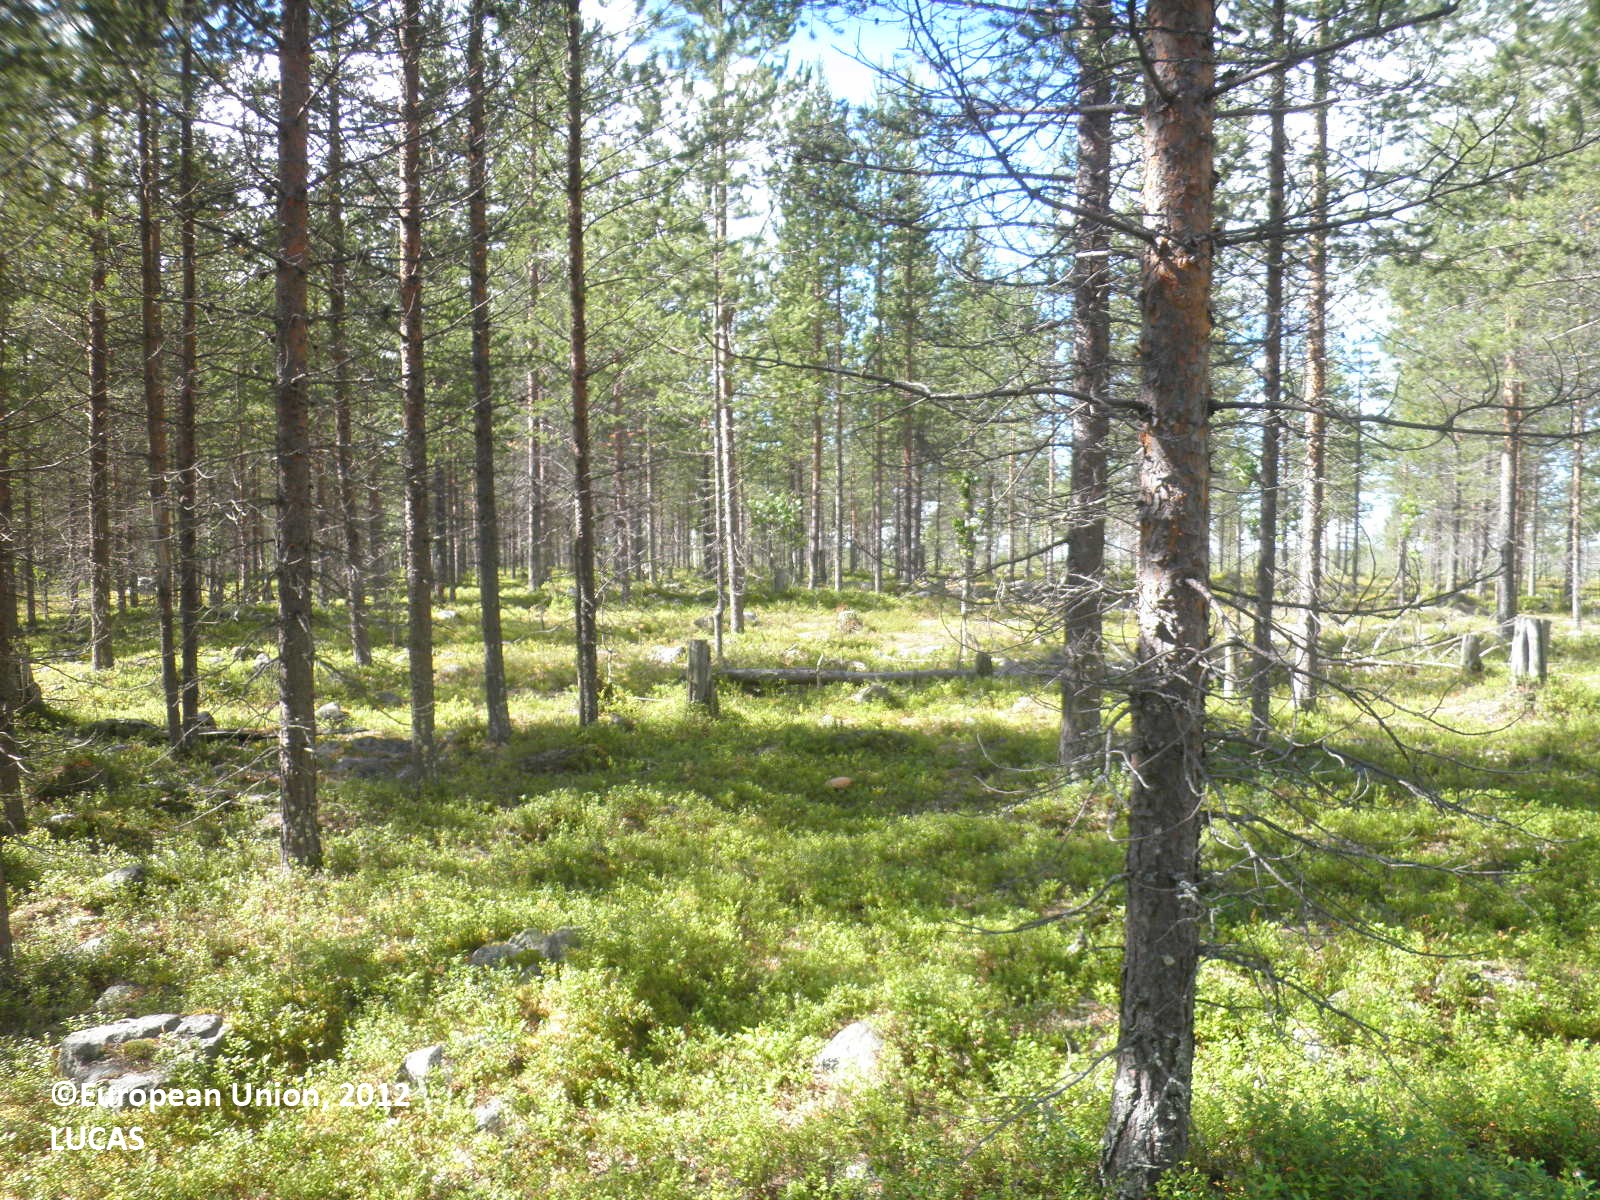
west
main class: Woodland
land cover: Pine dominated coniferous woodland
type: boreal forest
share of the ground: 50 - 75 %
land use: Forestry
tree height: > 5 m
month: August
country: FI
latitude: 67.1329
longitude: 28.9925
